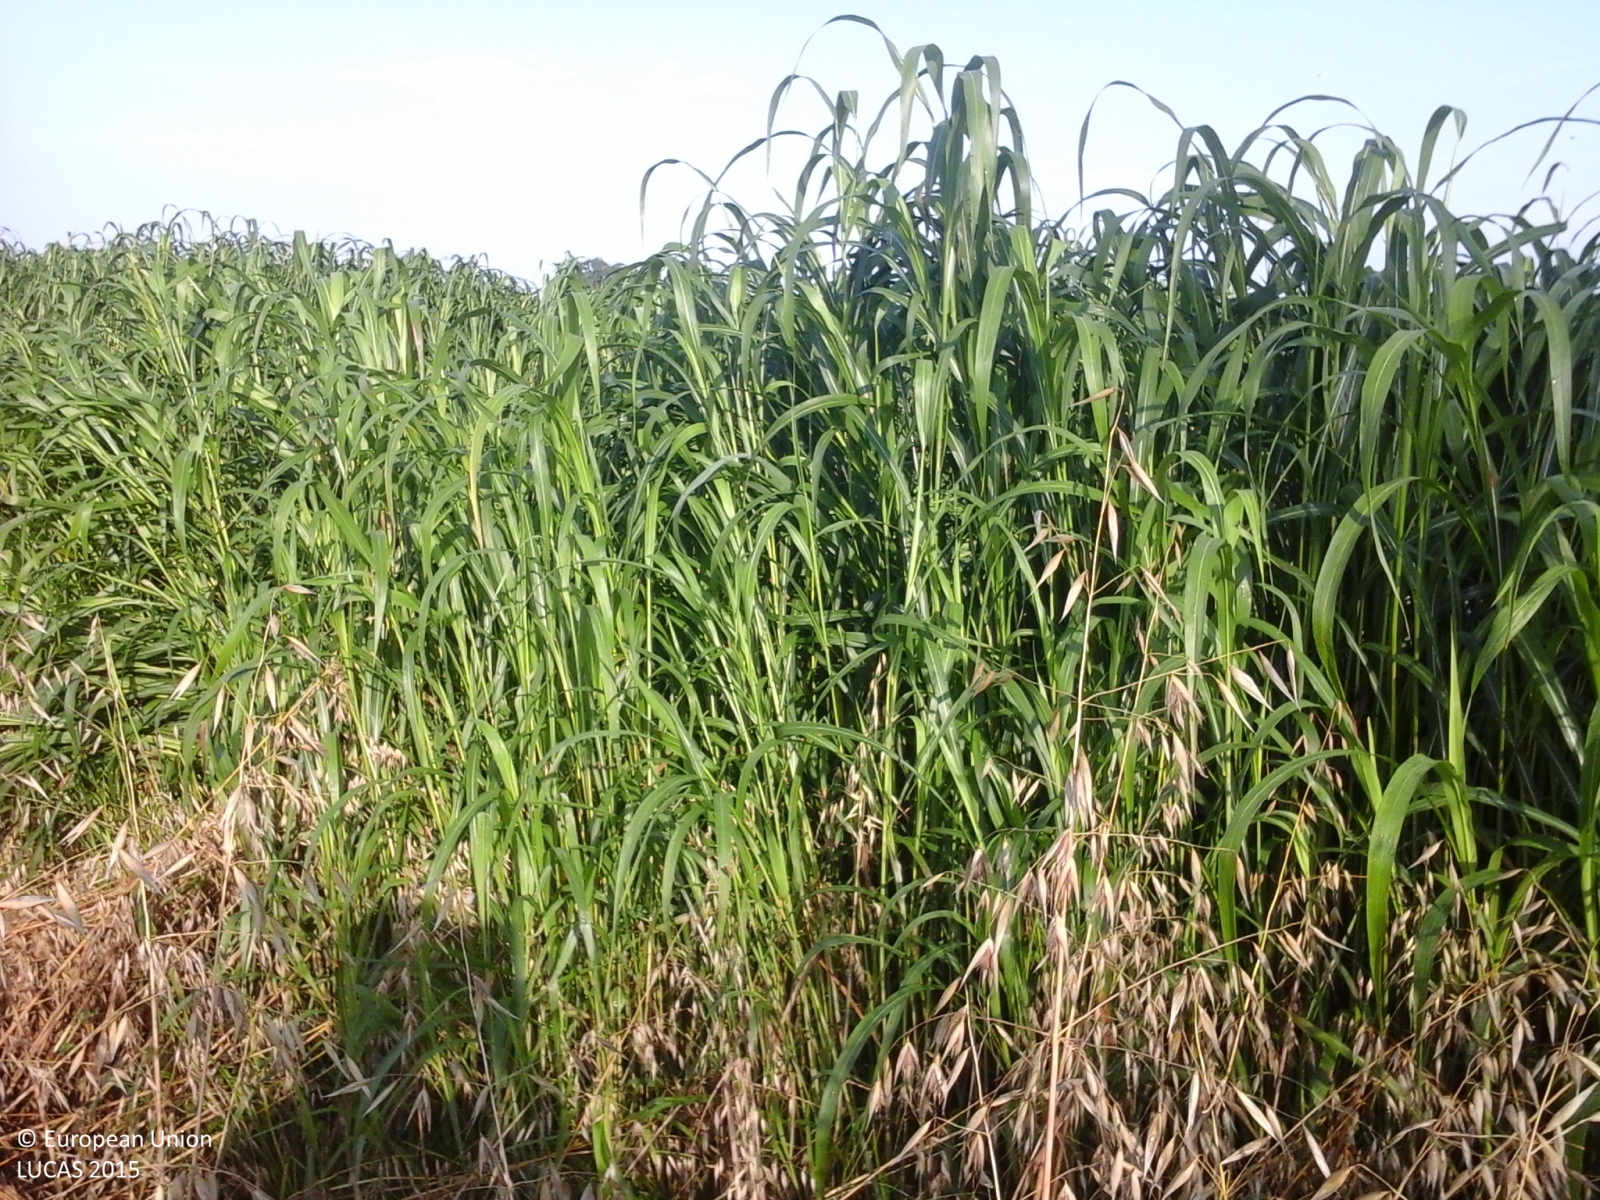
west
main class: Grassland
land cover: Spontaneously vegetated surfaces
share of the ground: > 75 %
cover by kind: herbaceous plants 100 %
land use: Agriculture (excluding fallow land and kitchen gardens)
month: June
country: IT
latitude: 44.5990
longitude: 10.9177
